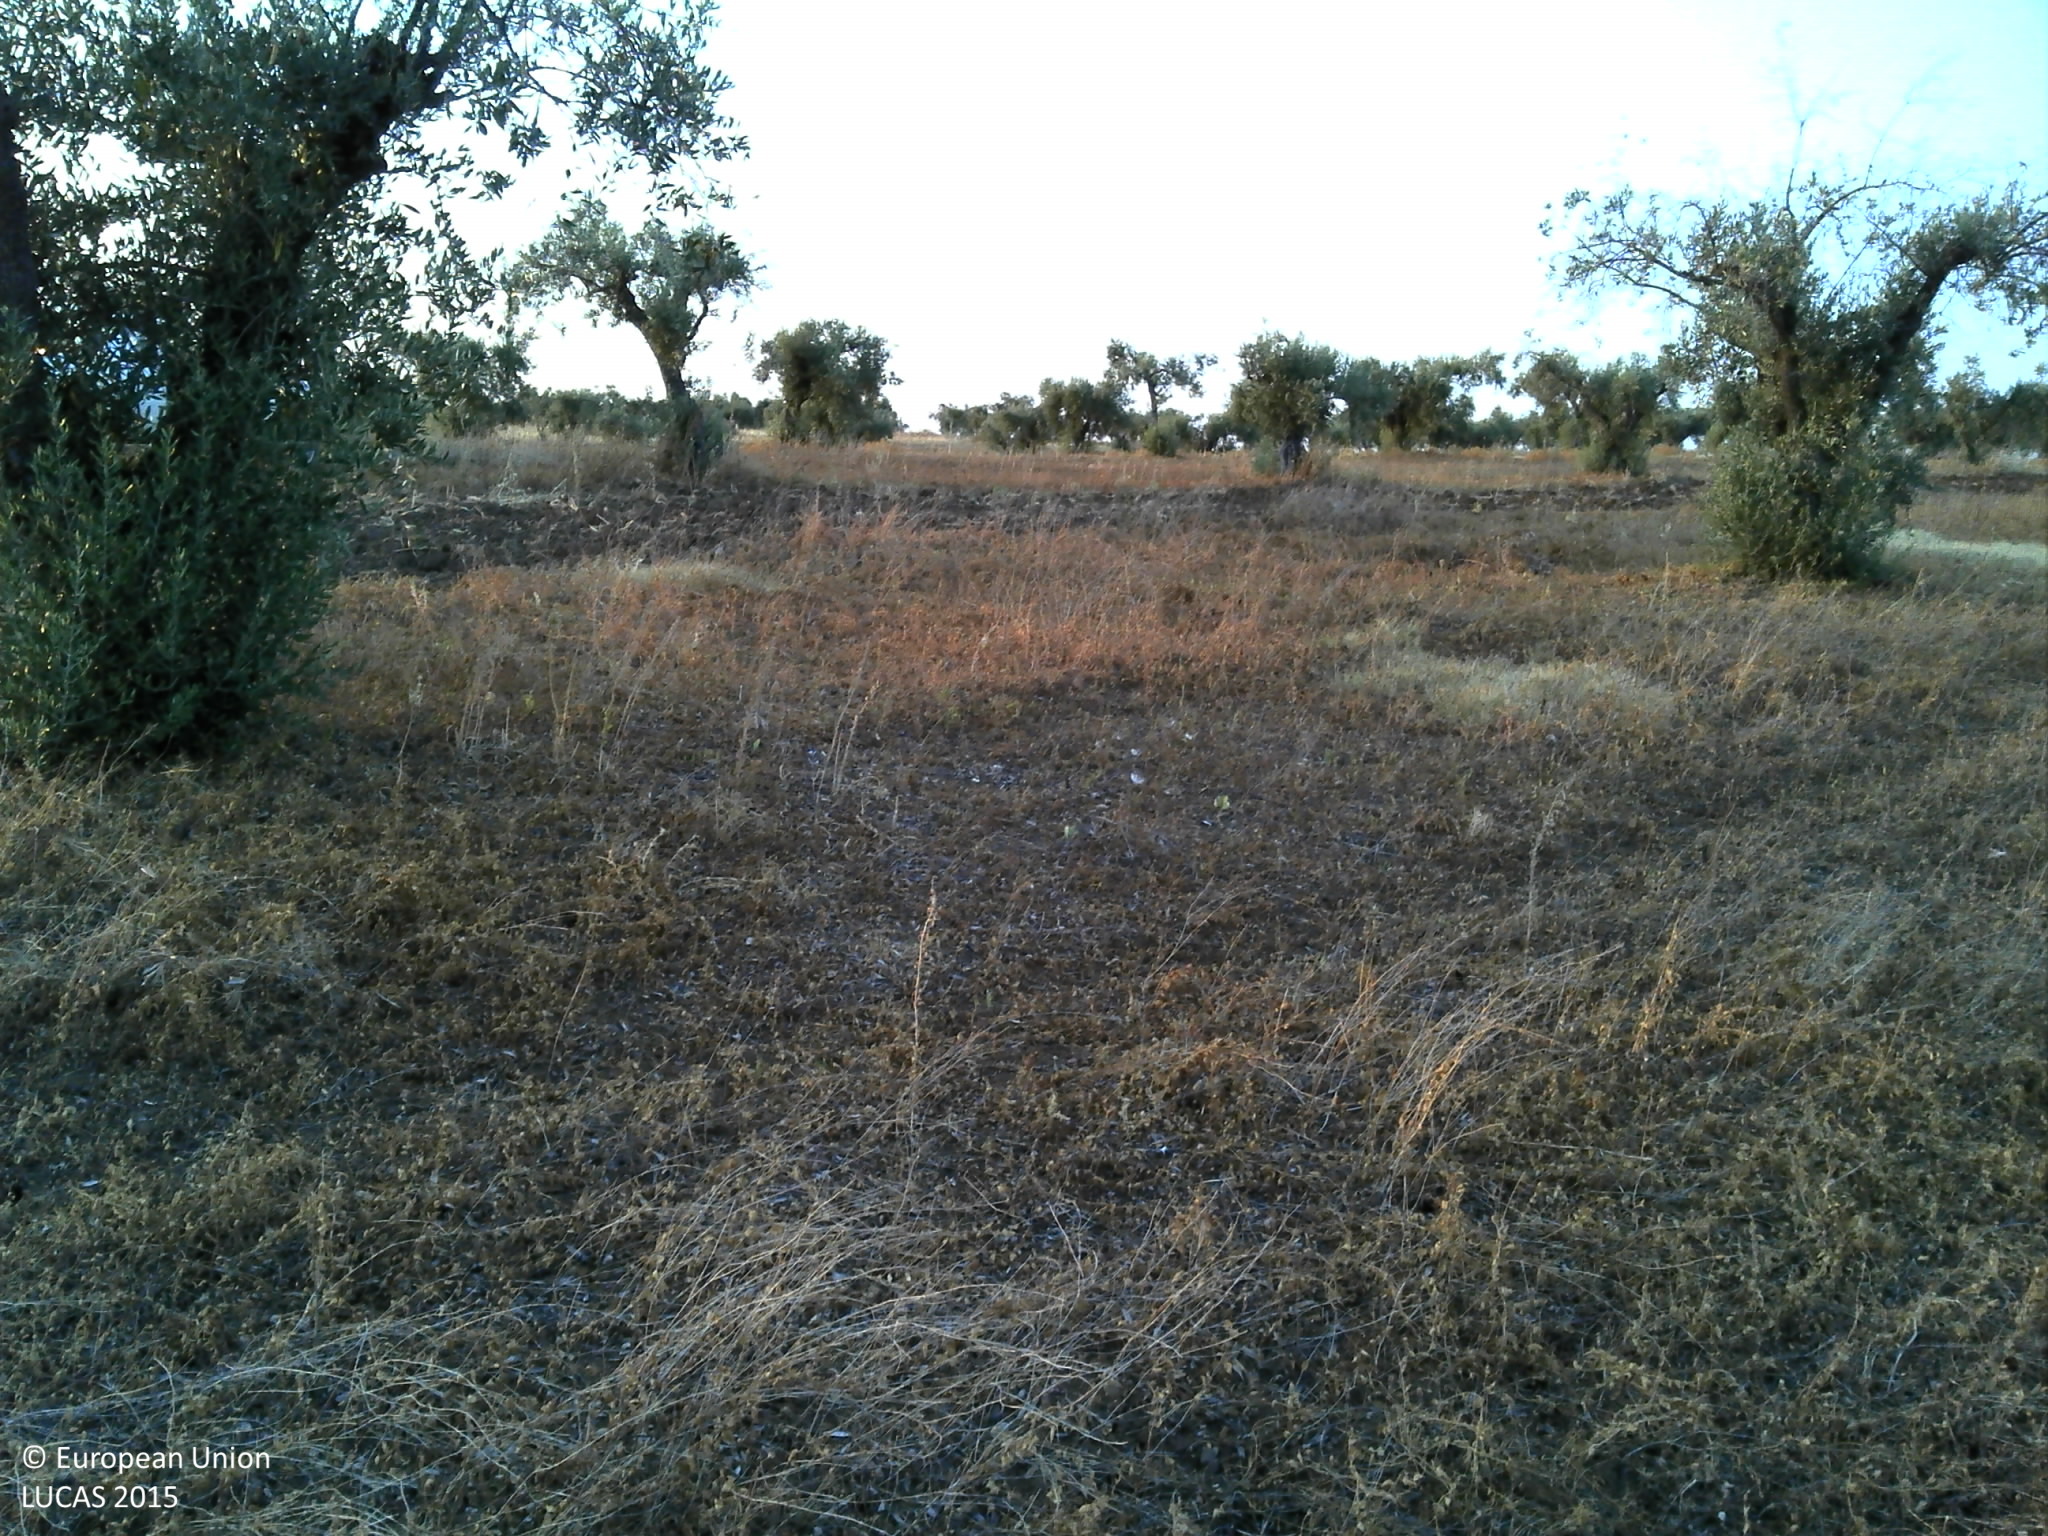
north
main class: Cropland
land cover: Olive groves
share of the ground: 25 - 50 %
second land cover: Grassland without tree/shrub cover
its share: 50 - 75 %
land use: Agriculture (excluding fallow land and kitchen gardens)
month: June
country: PT
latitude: 38.2891
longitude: -7.3188
